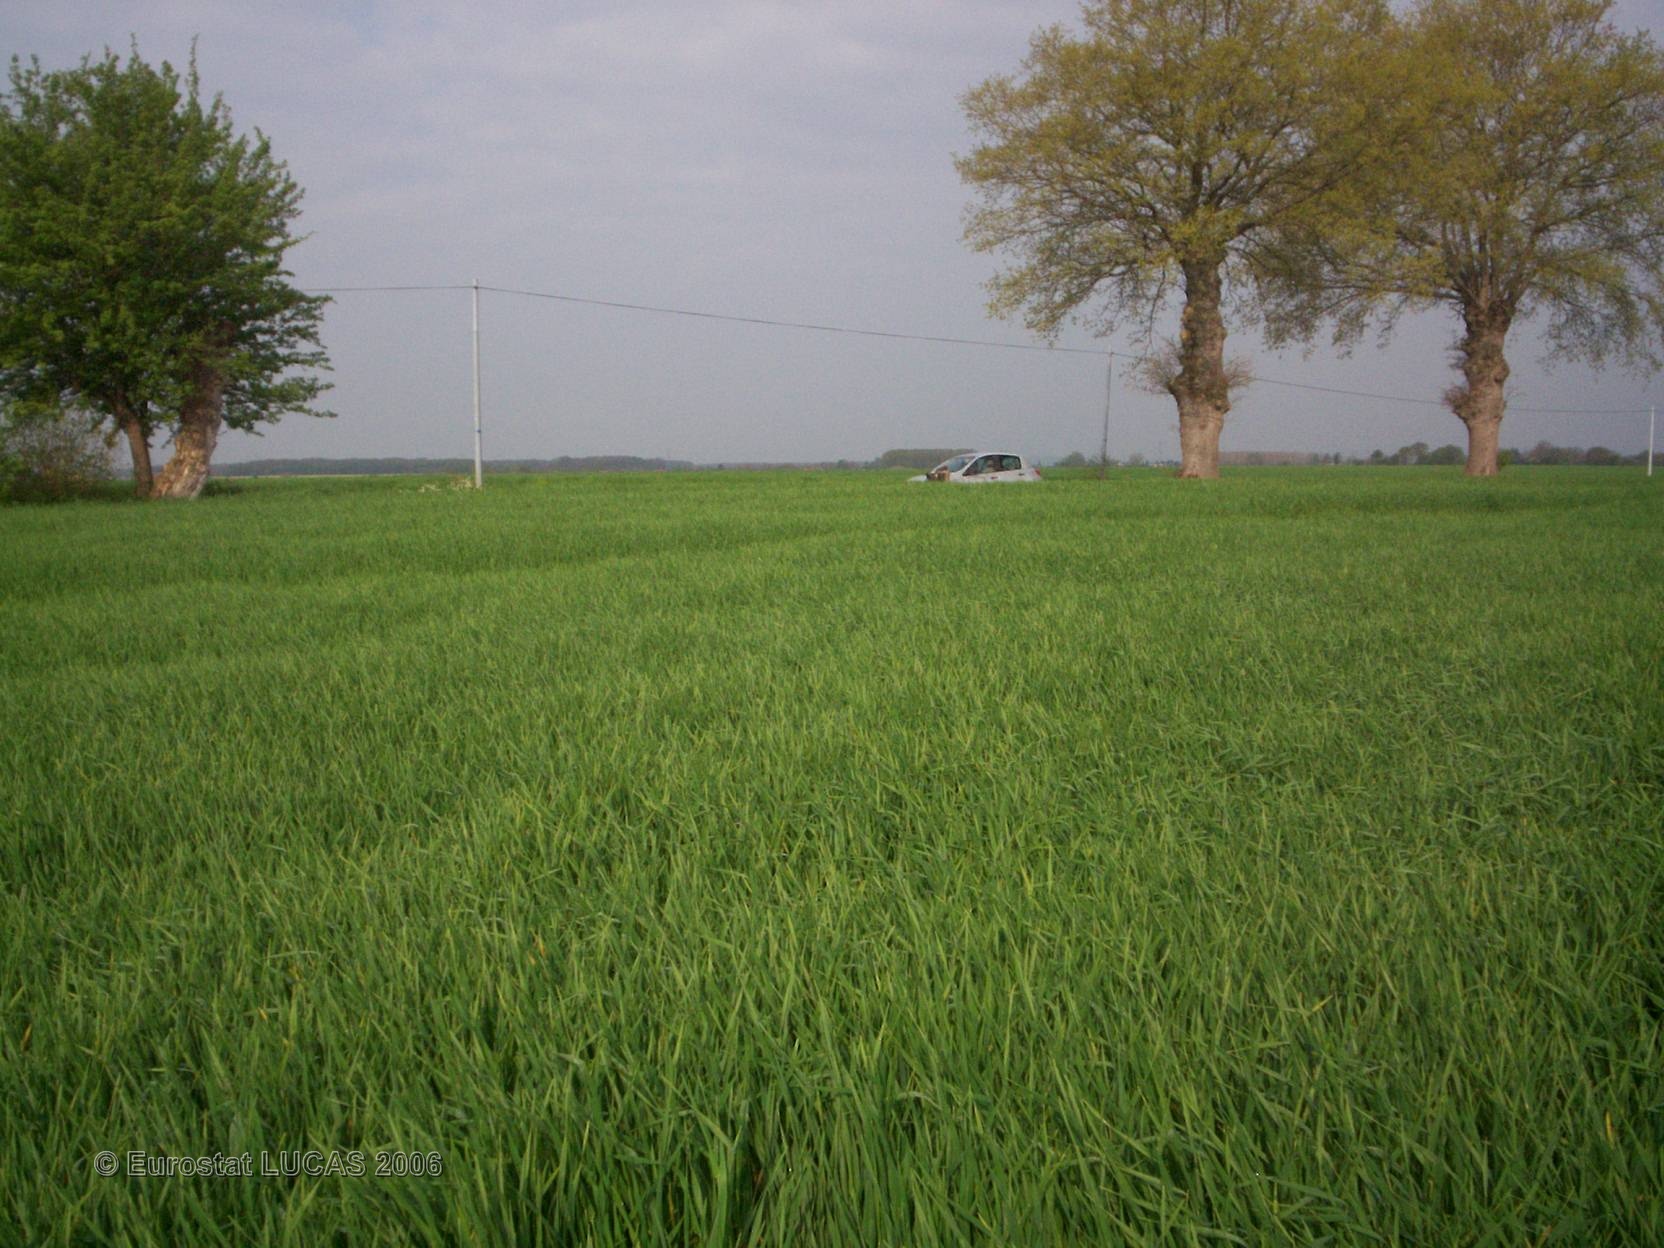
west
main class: Cropland
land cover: Barley
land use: Agriculture (excluding fallow land and kitchen gardens)
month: April
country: FR
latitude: 47.2298
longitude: 3.0877
